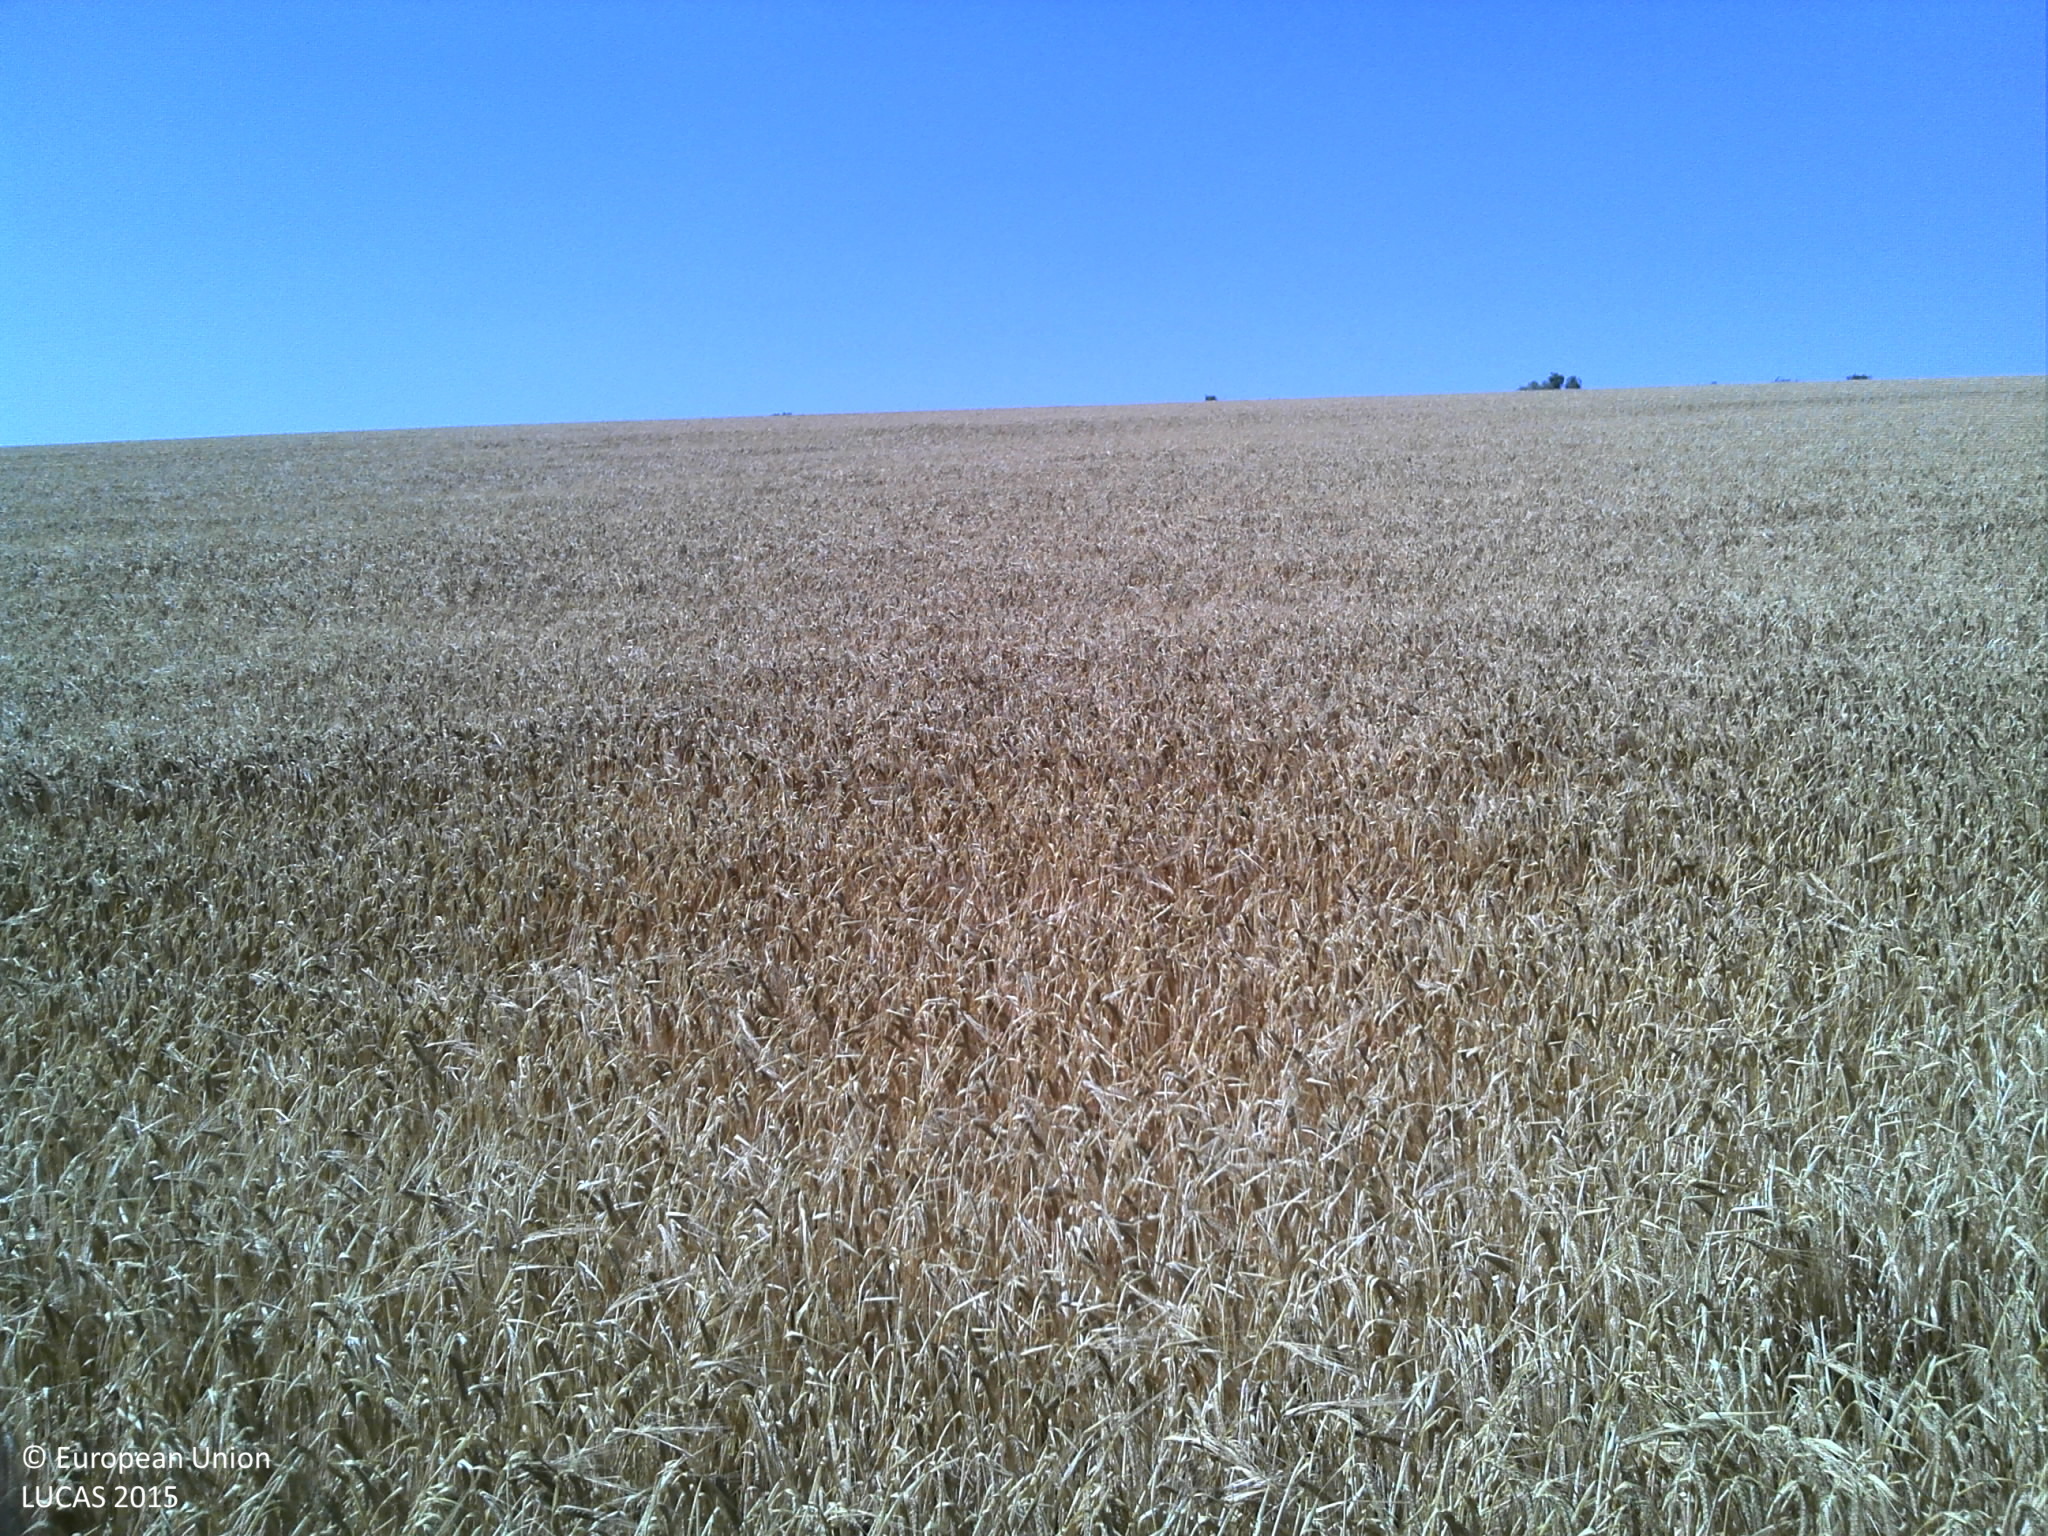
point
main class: Cropland
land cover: Barley
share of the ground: > 75 %
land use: Agriculture (excluding fallow land and kitchen gardens)
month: July
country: FR
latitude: 48.8519
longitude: 4.6685
